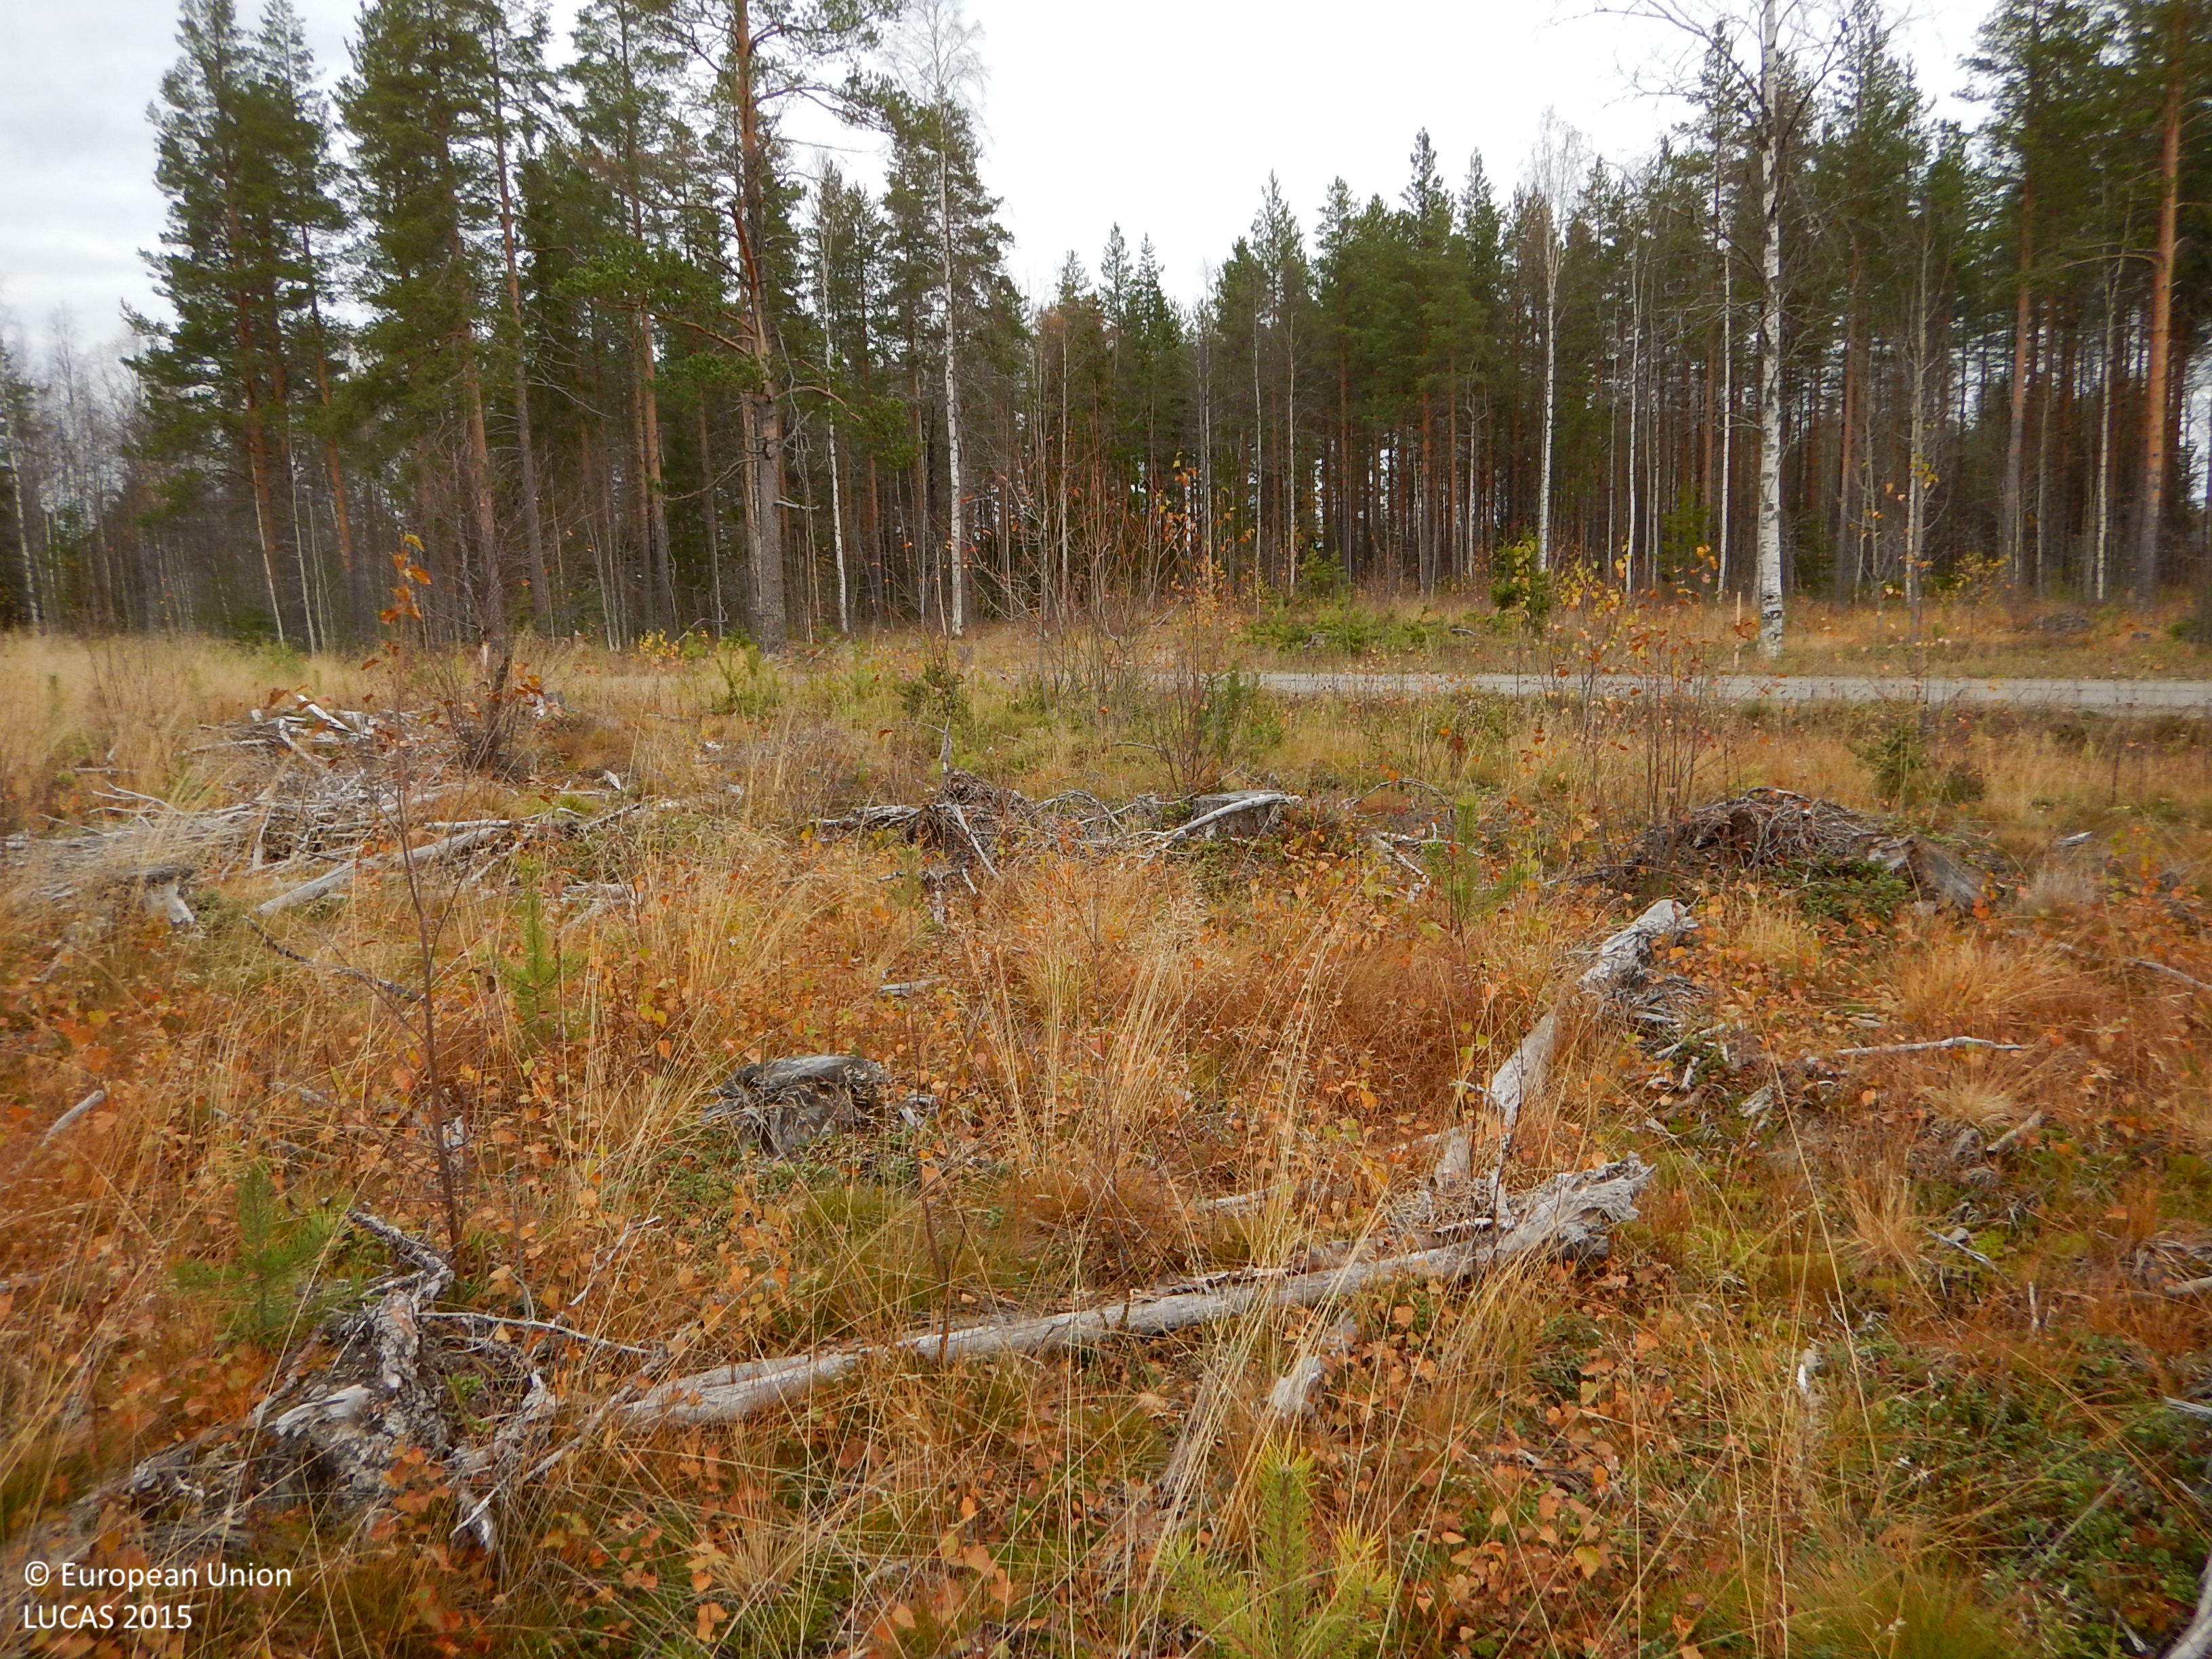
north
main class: Woodland
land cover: Other mixed woodland
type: boreal forest
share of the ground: 25 - 50 %
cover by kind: broadleaved forest trees 30 %, shrubs 25 %, herbaceous plants 20 %, lichens and mosses 15 %, coniferous forest trees 10 %
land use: Forestry
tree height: < 5 m
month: October
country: SE
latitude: 64.9765
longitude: 21.1005
